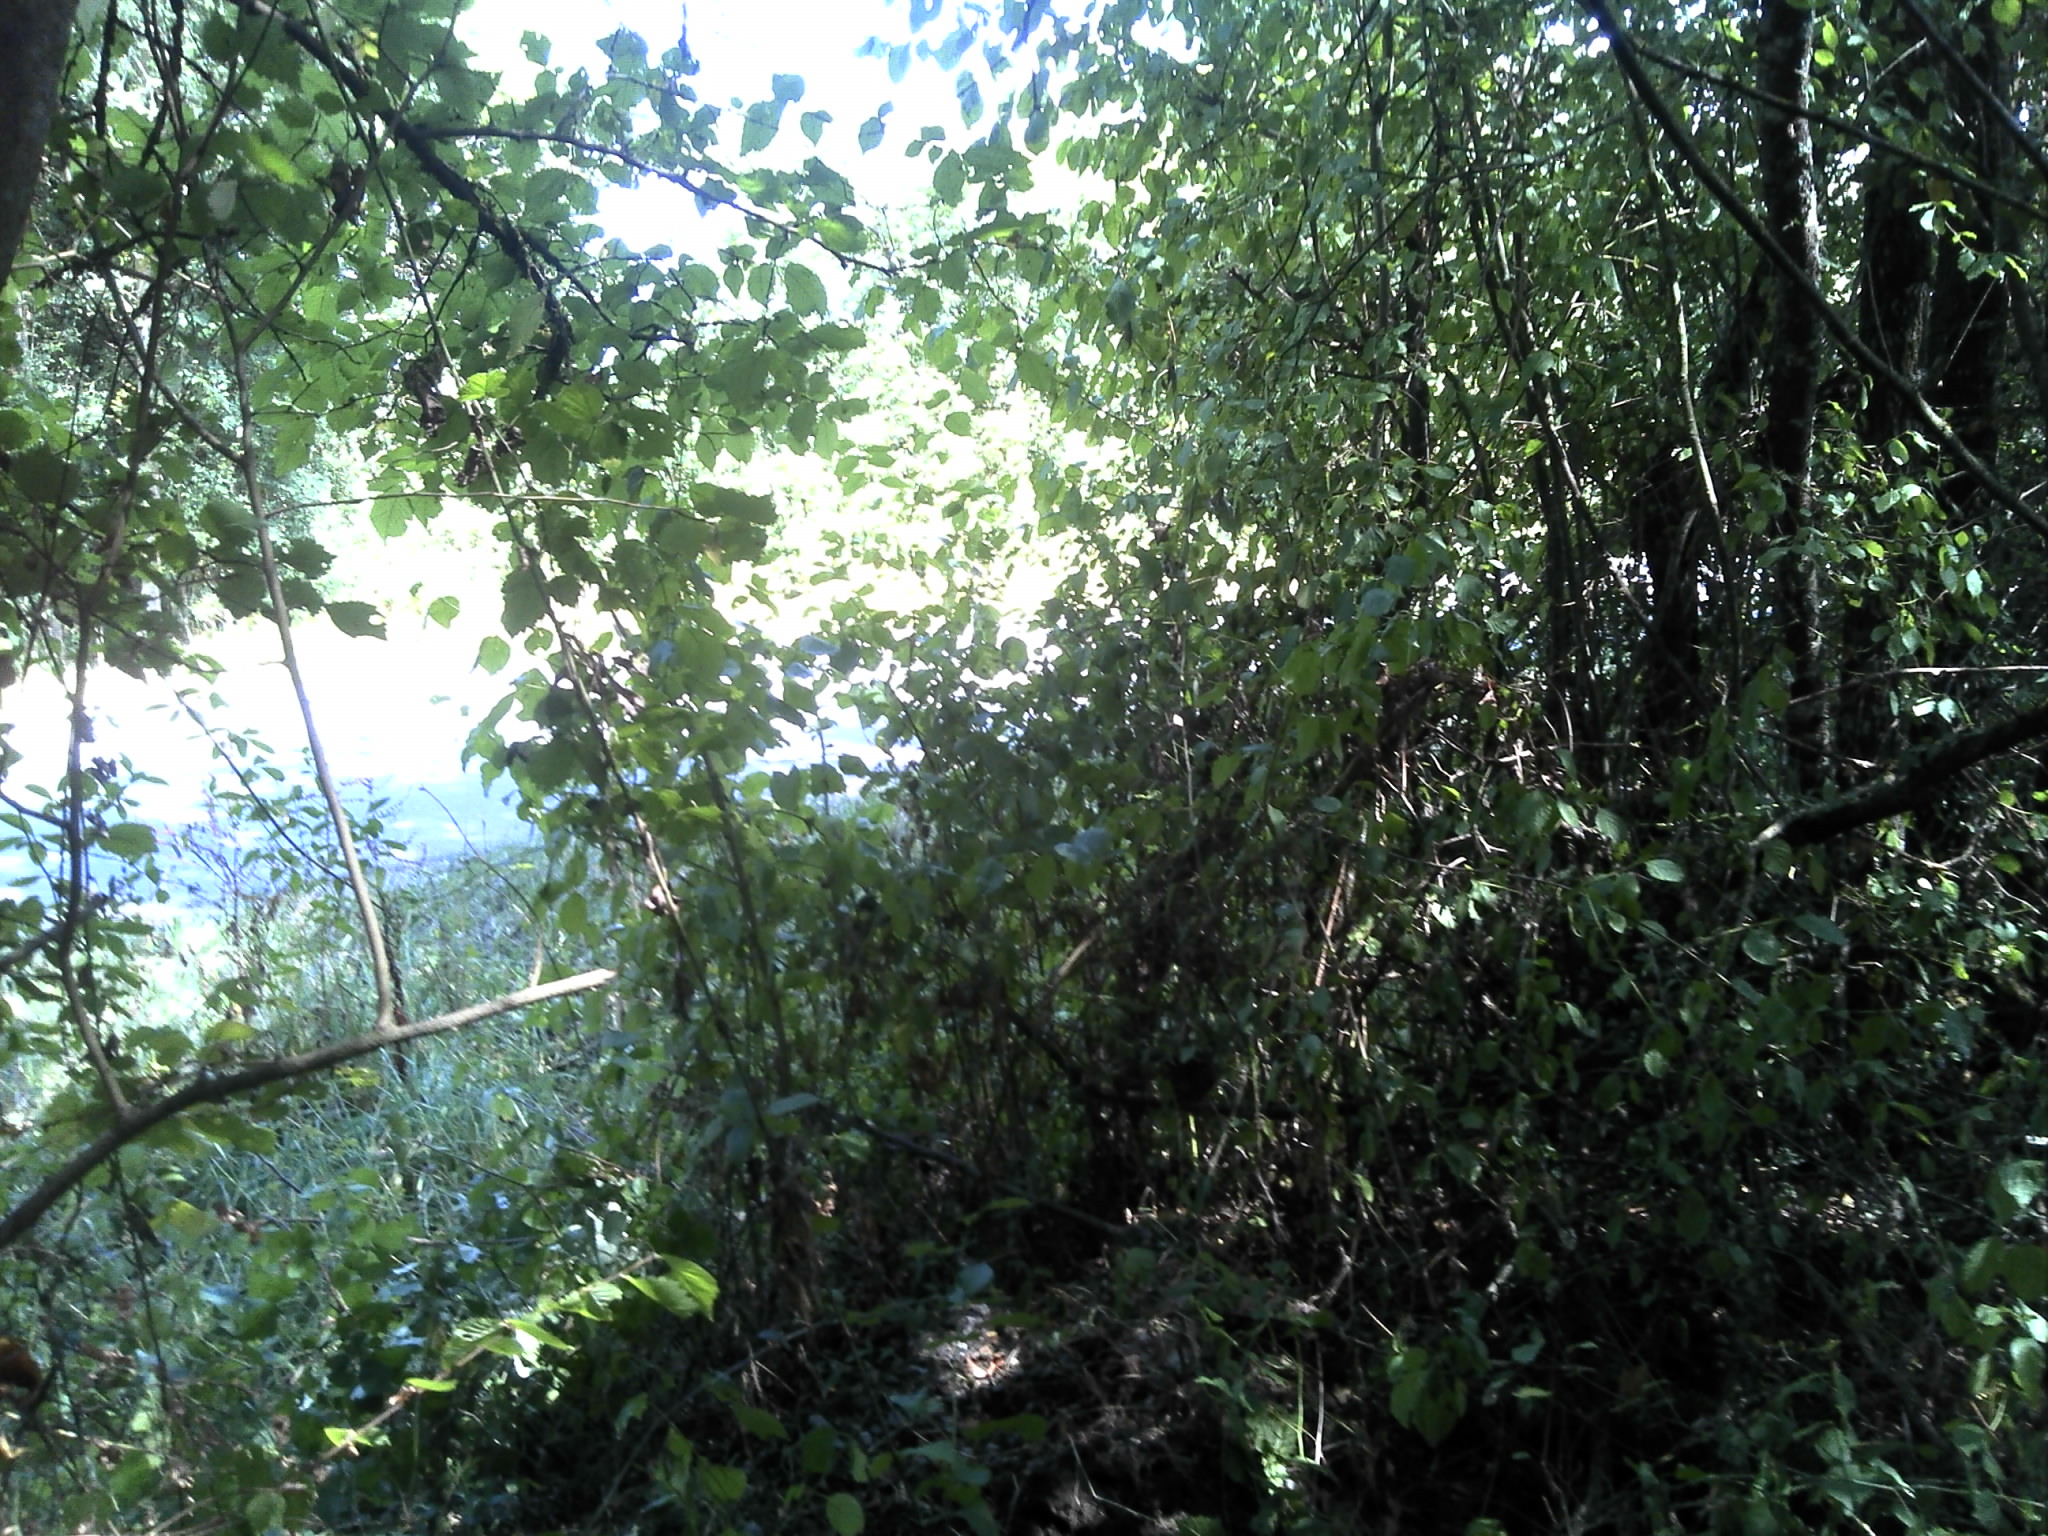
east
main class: Woodland
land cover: Broadleaved woodland
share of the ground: > 75 %
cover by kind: broadleaved forest trees 80 %, shrubs 15 %, herbaceous plants 5 %
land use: Semi-natural and natural areas not in use
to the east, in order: Broadleaved woodland; Ditches and canals; Grass margins; Paved roads, cycling and walking lanes; Grass margins; Ditches and canals; Broadleaved woodland; Grassland without tree/shrub cover; Broadleaved woodland; Grassland without tree/shrub cover; Managed hedges; Grassland without tree/shrub cover; Abandoned hedges; Grassland without tree/shrub cover
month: August
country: FR
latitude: 46.5339
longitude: 1.6853
